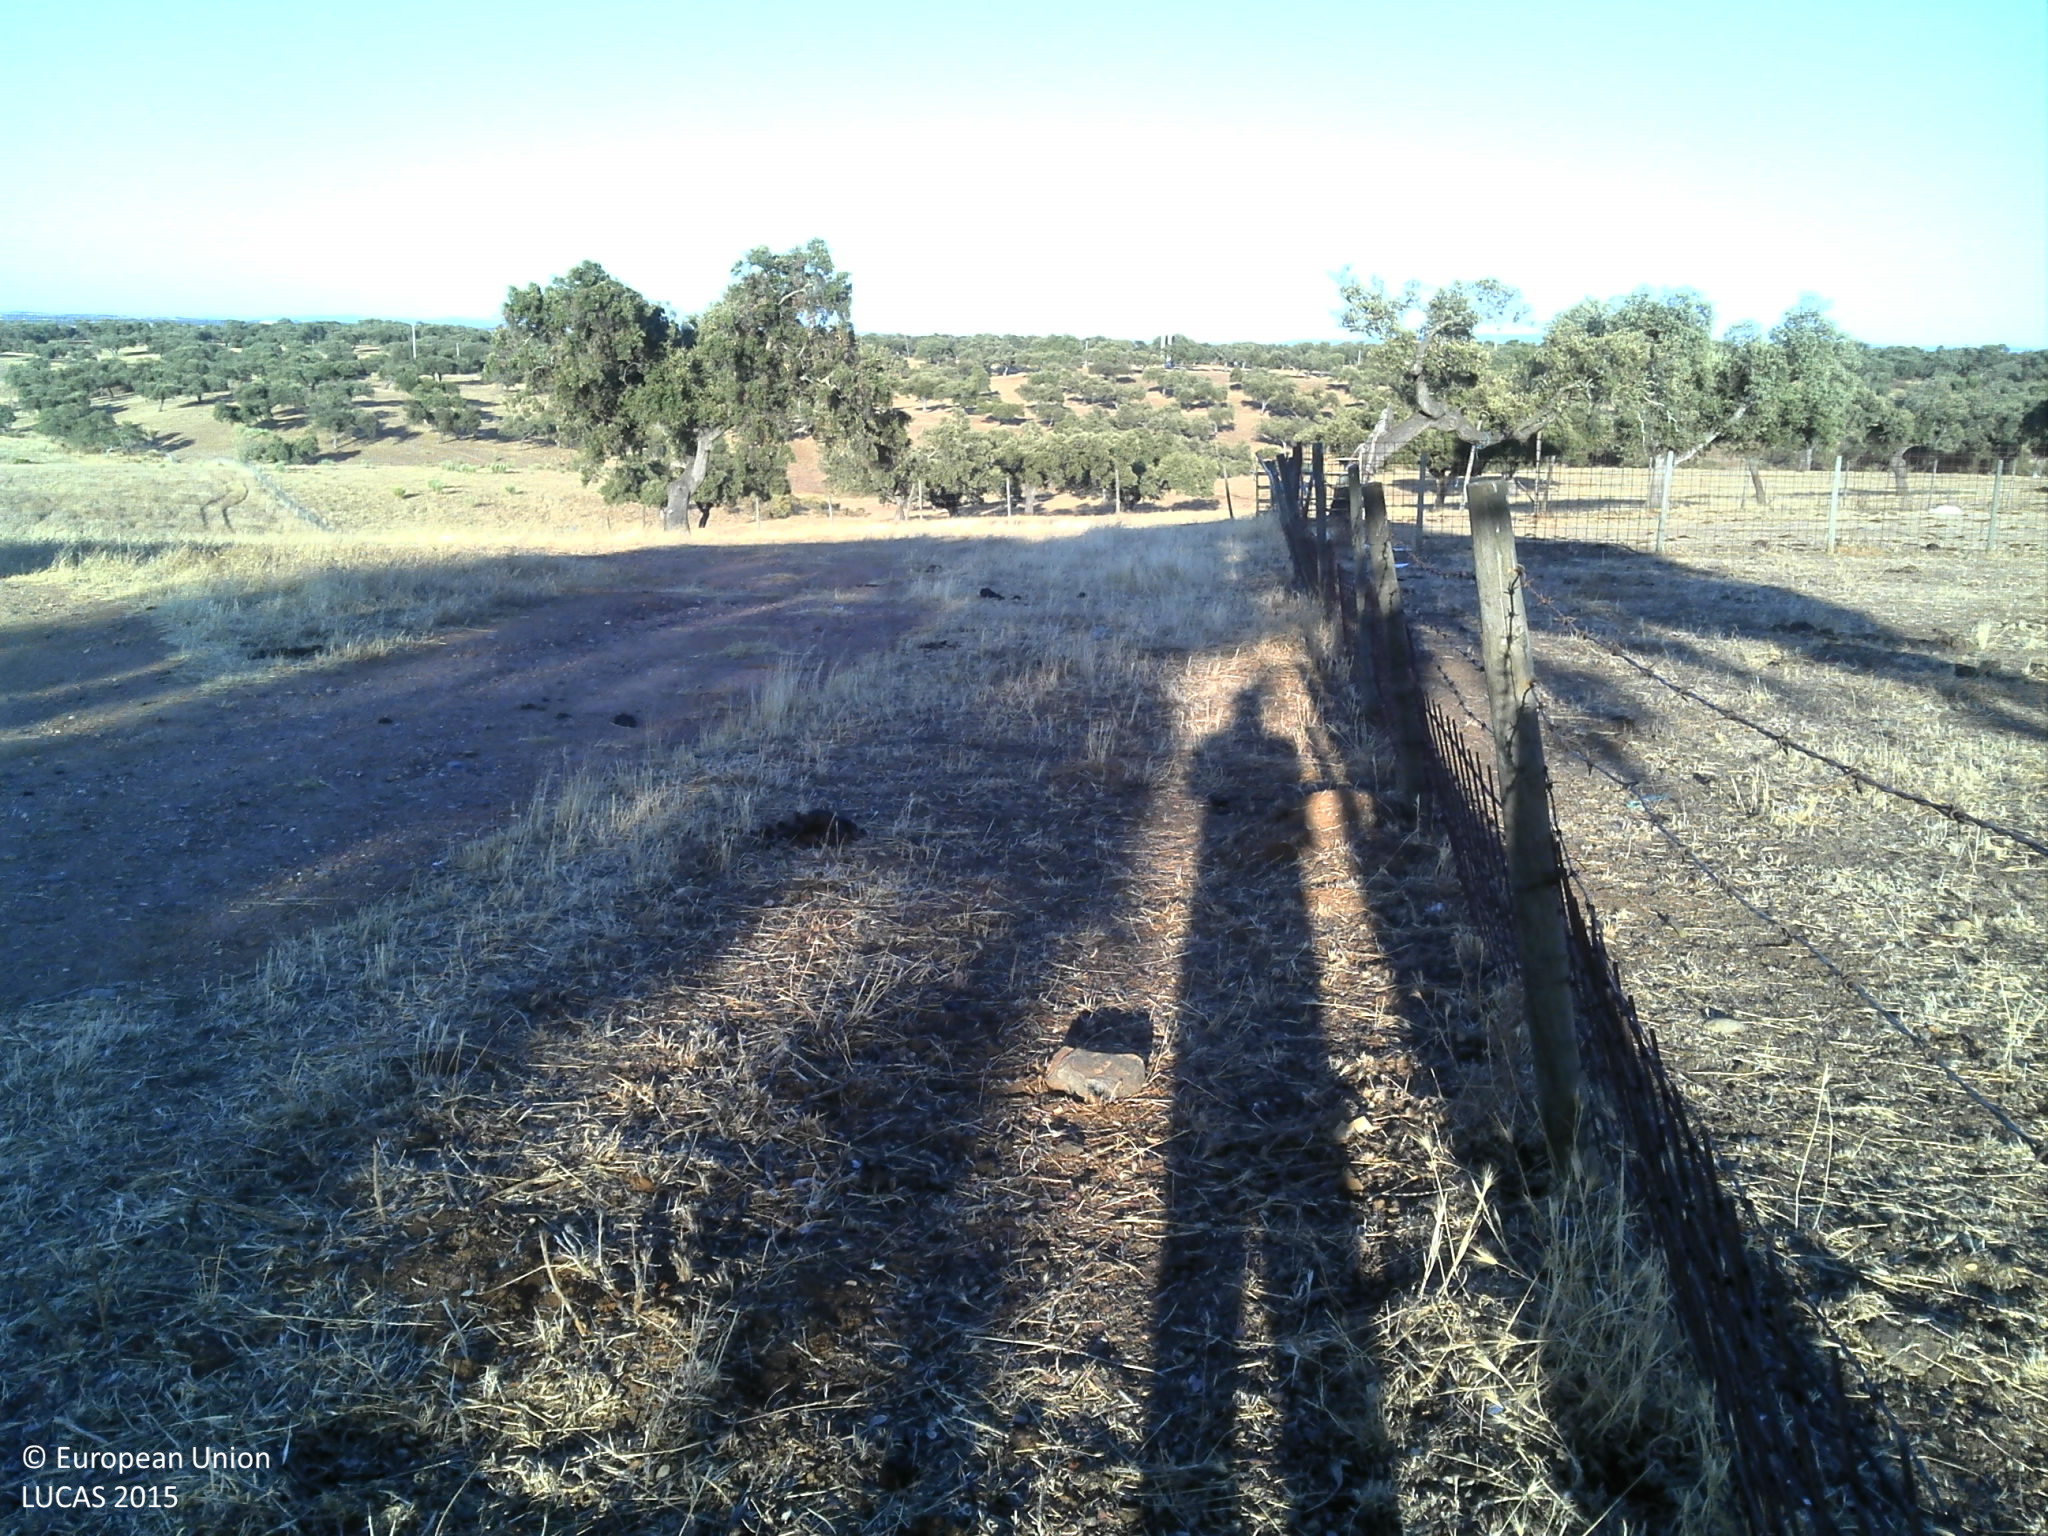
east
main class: Woodland
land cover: Broadleaved woodland
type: broadleaved evergreen forest
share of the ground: 10 - 25 %
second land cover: Grassland without tree/shrub cover
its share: 10 - 25 %
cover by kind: unconsolidated bare surface 70 %, broadleaved forest trees 15 %, herbaceous plants 15 %
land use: Forestry
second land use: Agriculture (excluding fallow land and kitchen gardens)
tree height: > 5 m
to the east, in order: Broadleaved woodland; Grassland without tree/shrub cover; Fences; Grassland without tree/shrub cover; Tracks; Grassland without tree/shrub cover; Single bushes/trees; Grassland without tree/shrub cover; Broadleaved woodland; Grassland without tree/shrub cover; Shrubland without tree cover; Grassland without tree/shrub cover
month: July
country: PT
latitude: 38.1658
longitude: -7.2866
